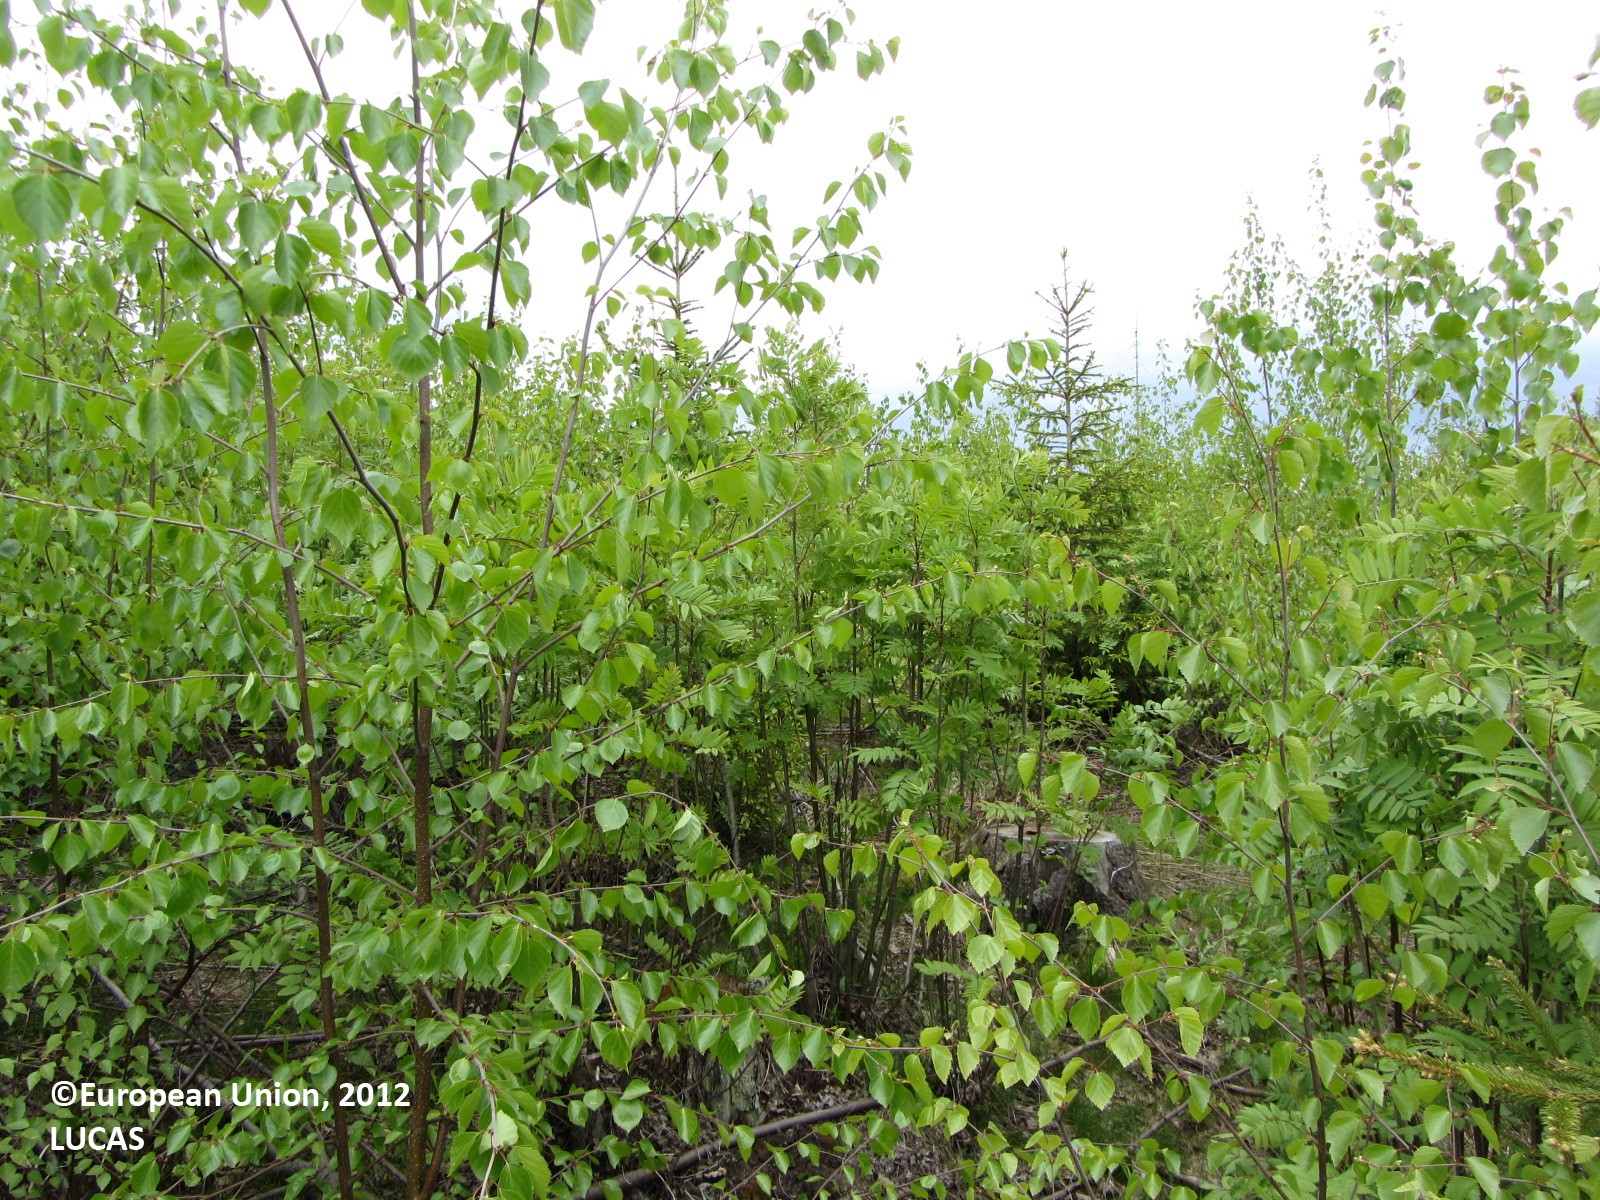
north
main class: Woodland
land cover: Spruce dominated mixed woodland
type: boreal forest
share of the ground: > 75 %
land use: Forestry
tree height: < 5 m
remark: Nursery
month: May
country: FI
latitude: 62.2360
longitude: 25.4102
